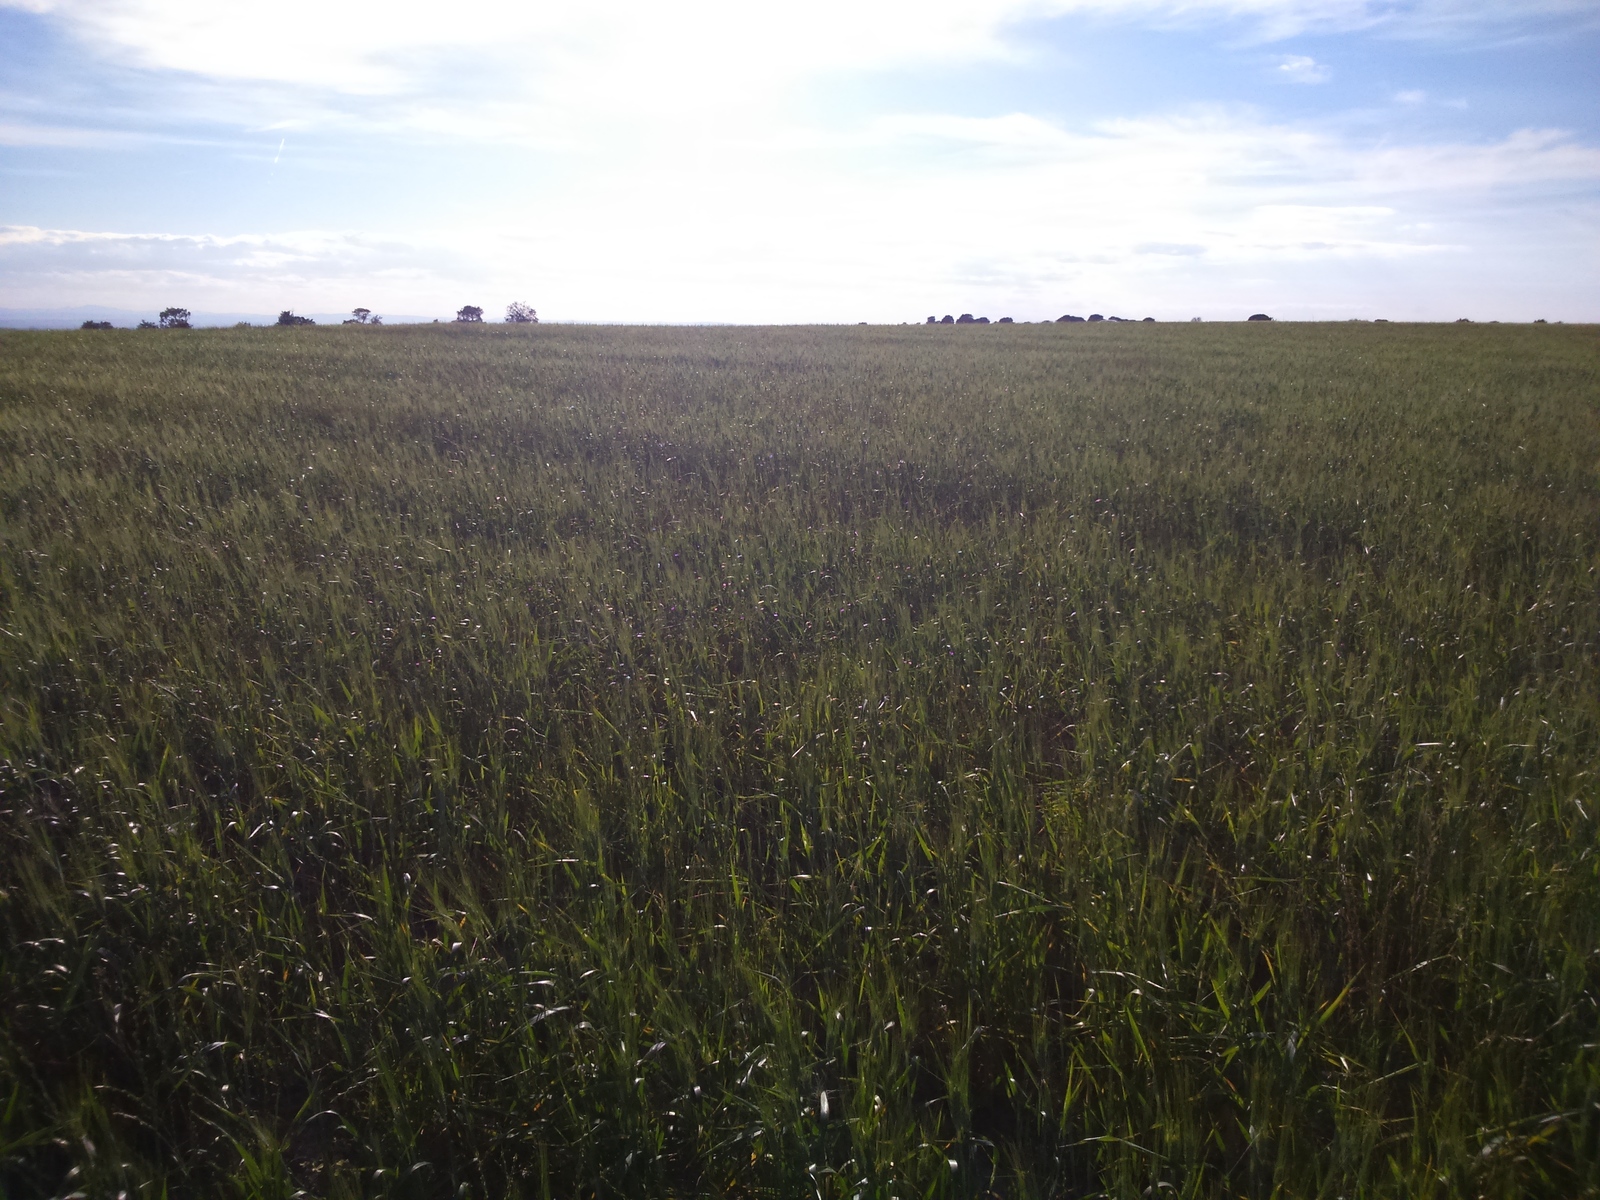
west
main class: Cropland
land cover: Durum wheat
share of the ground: > 75 %
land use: Agriculture (excluding fallow land and kitchen gardens)
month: April
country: ES
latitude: 41.4389
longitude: -0.2724
